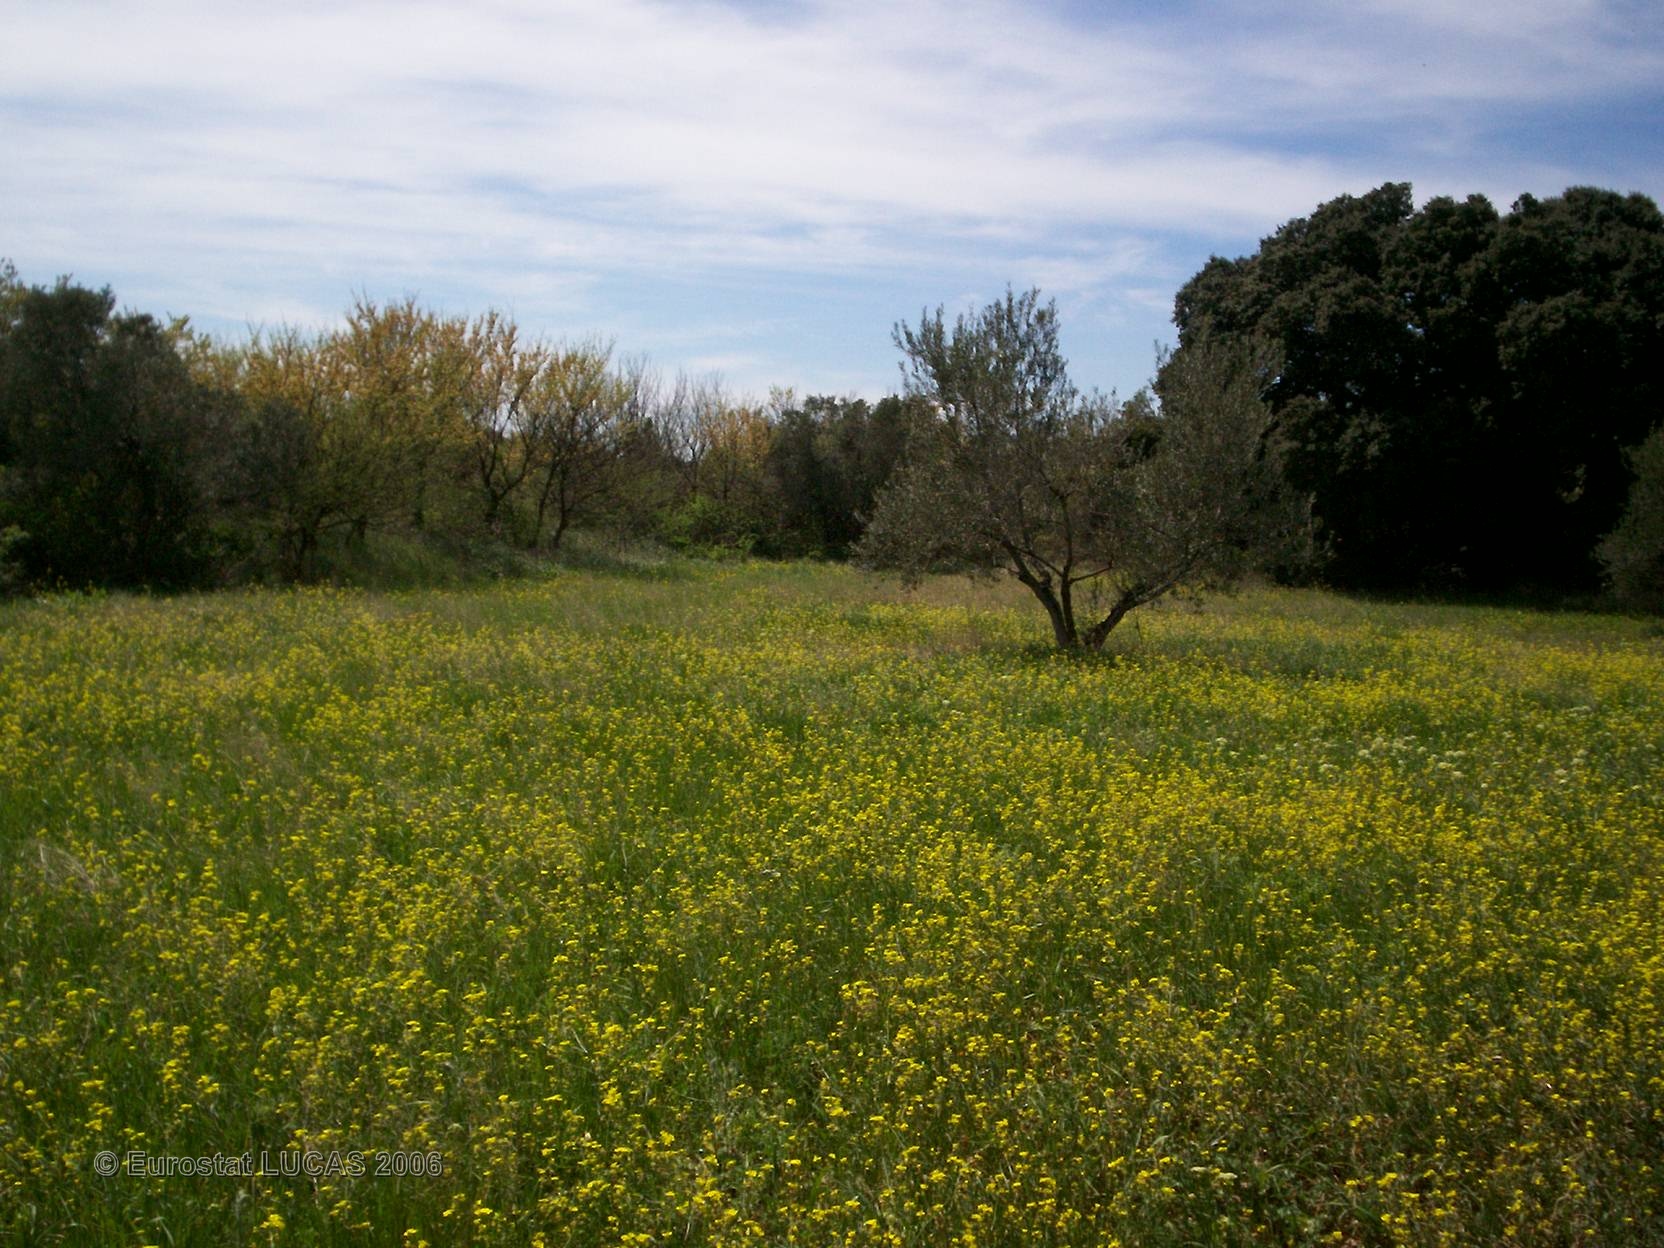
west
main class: Cropland
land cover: Olive groves
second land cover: Grassland with sparse tree/shrub cover
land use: Agriculture (excluding fallow land and kitchen gardens)
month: April
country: FR
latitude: 43.7027
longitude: 4.9340
